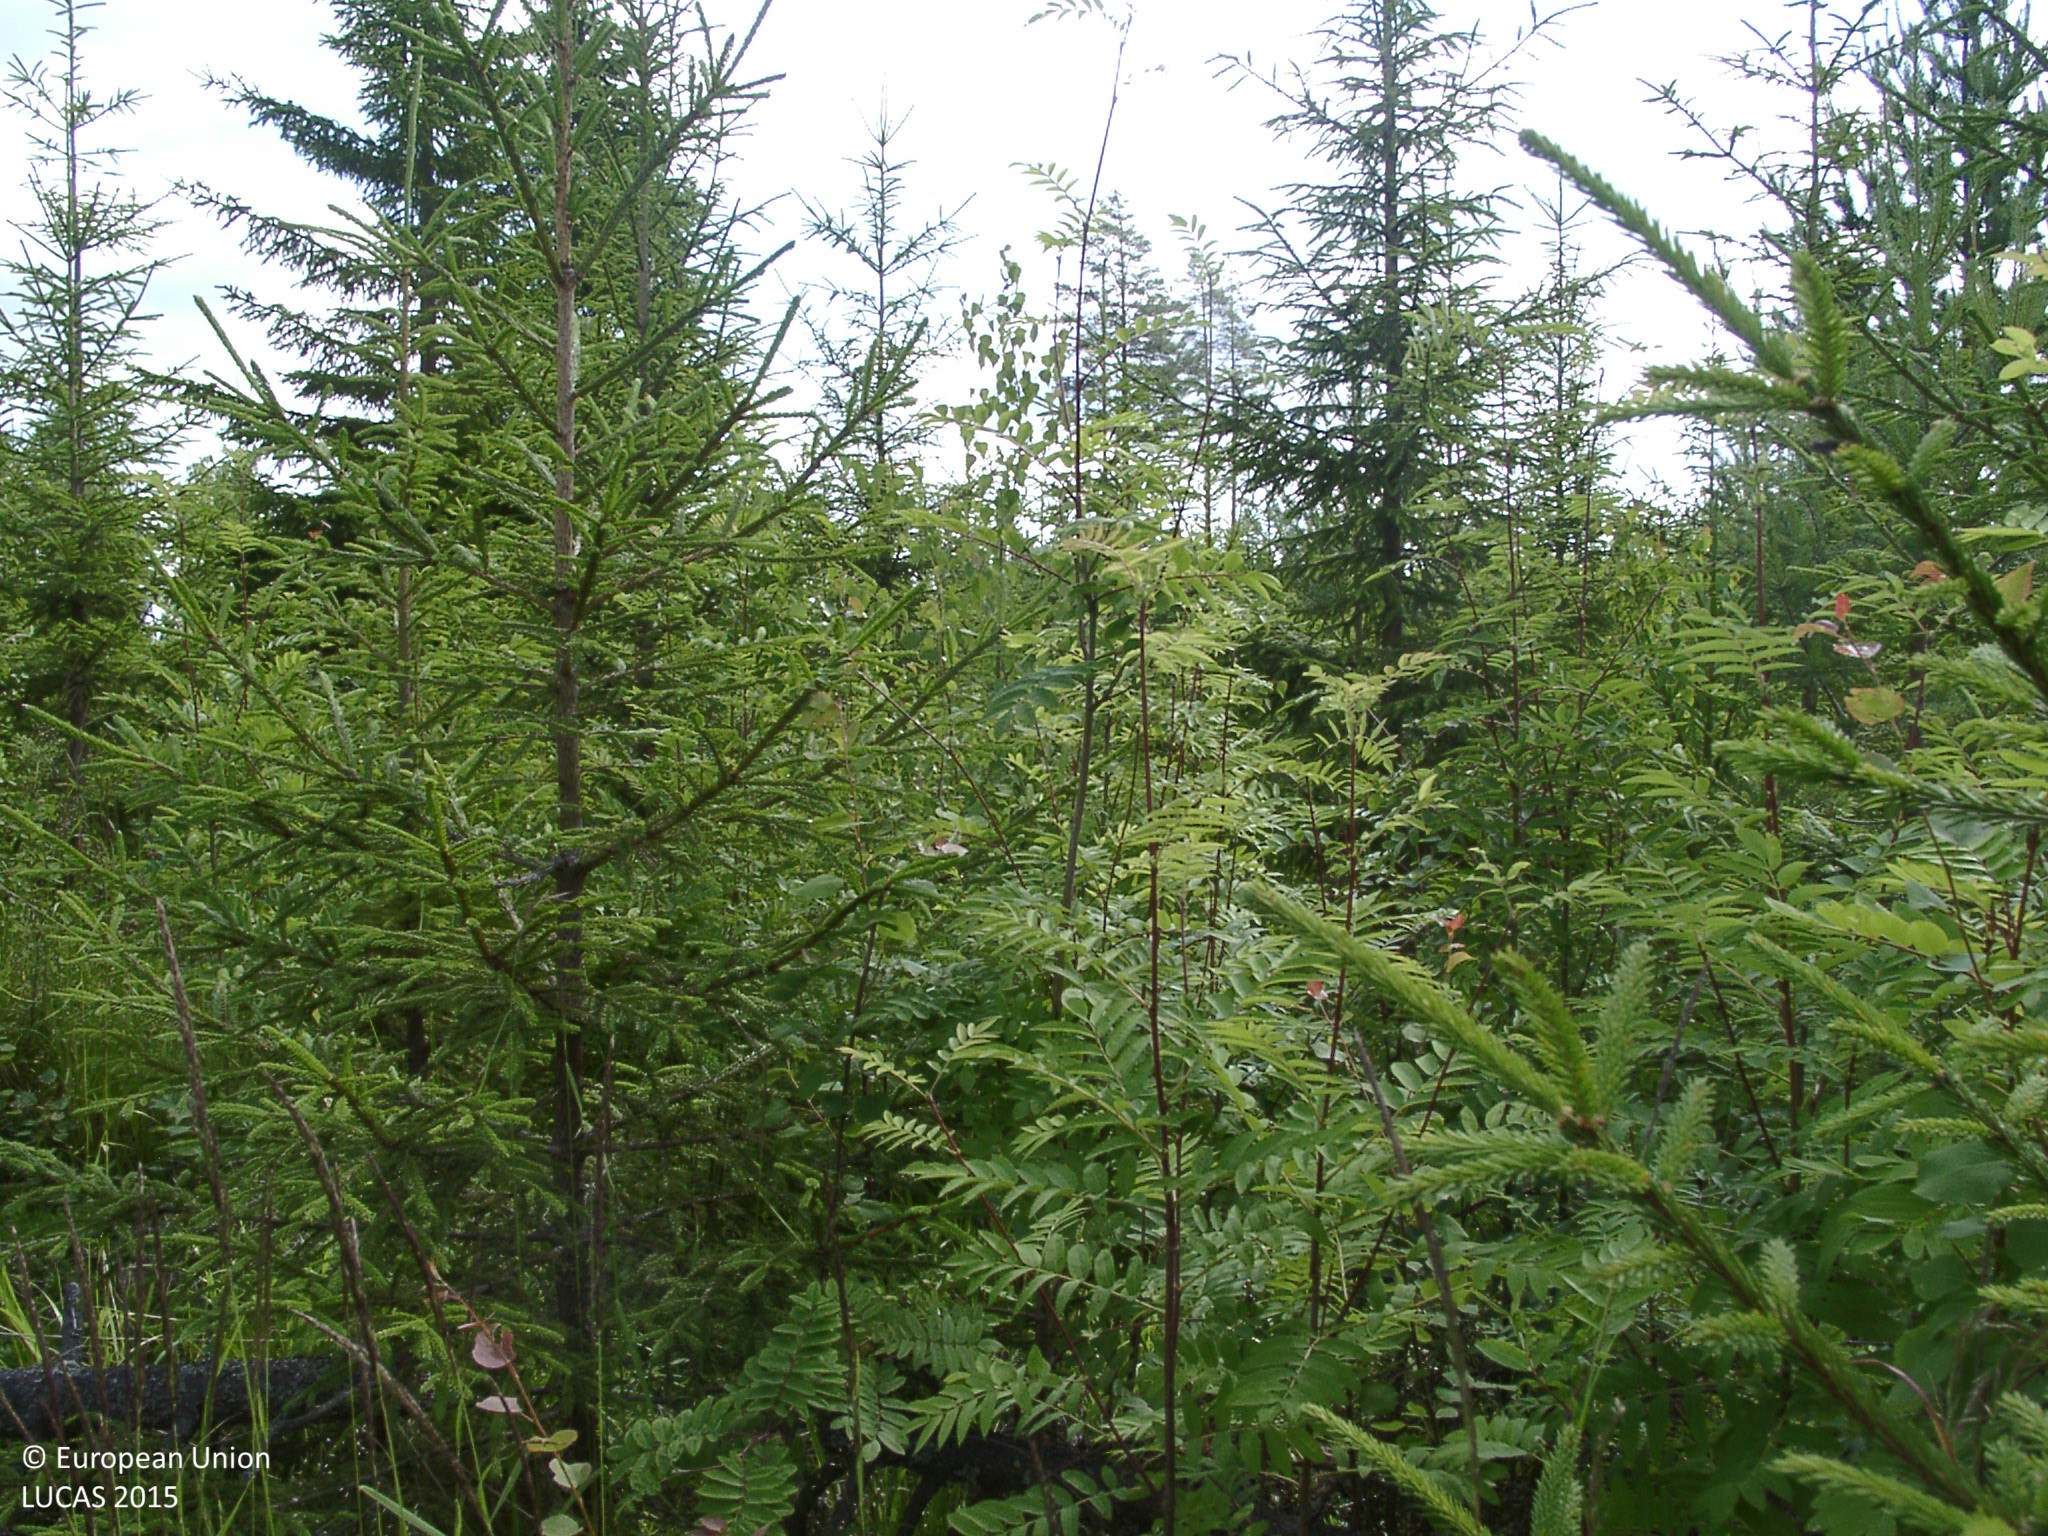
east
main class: Woodland
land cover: Spruce dominated mixed woodland
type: boreal forest
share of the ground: 50 - 75 %
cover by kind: coniferous forest trees 45 %, broadleaved forest trees 20 %, shrubs 20 %, herbaceous plants 15 %
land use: Forestry
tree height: < 5 m
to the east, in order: Spruce dominated mixed woodland; Ditches and canals; Tracks; Ditches and canals; Electric lines; Grassland without tree/shrub cover; Other mixed woodland; Fences; Grassland without tree/shrub cover; Fences; Spruce dominated mixed woodland; Shruby margins
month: July
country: FI
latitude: 61.5816
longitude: 24.9697
